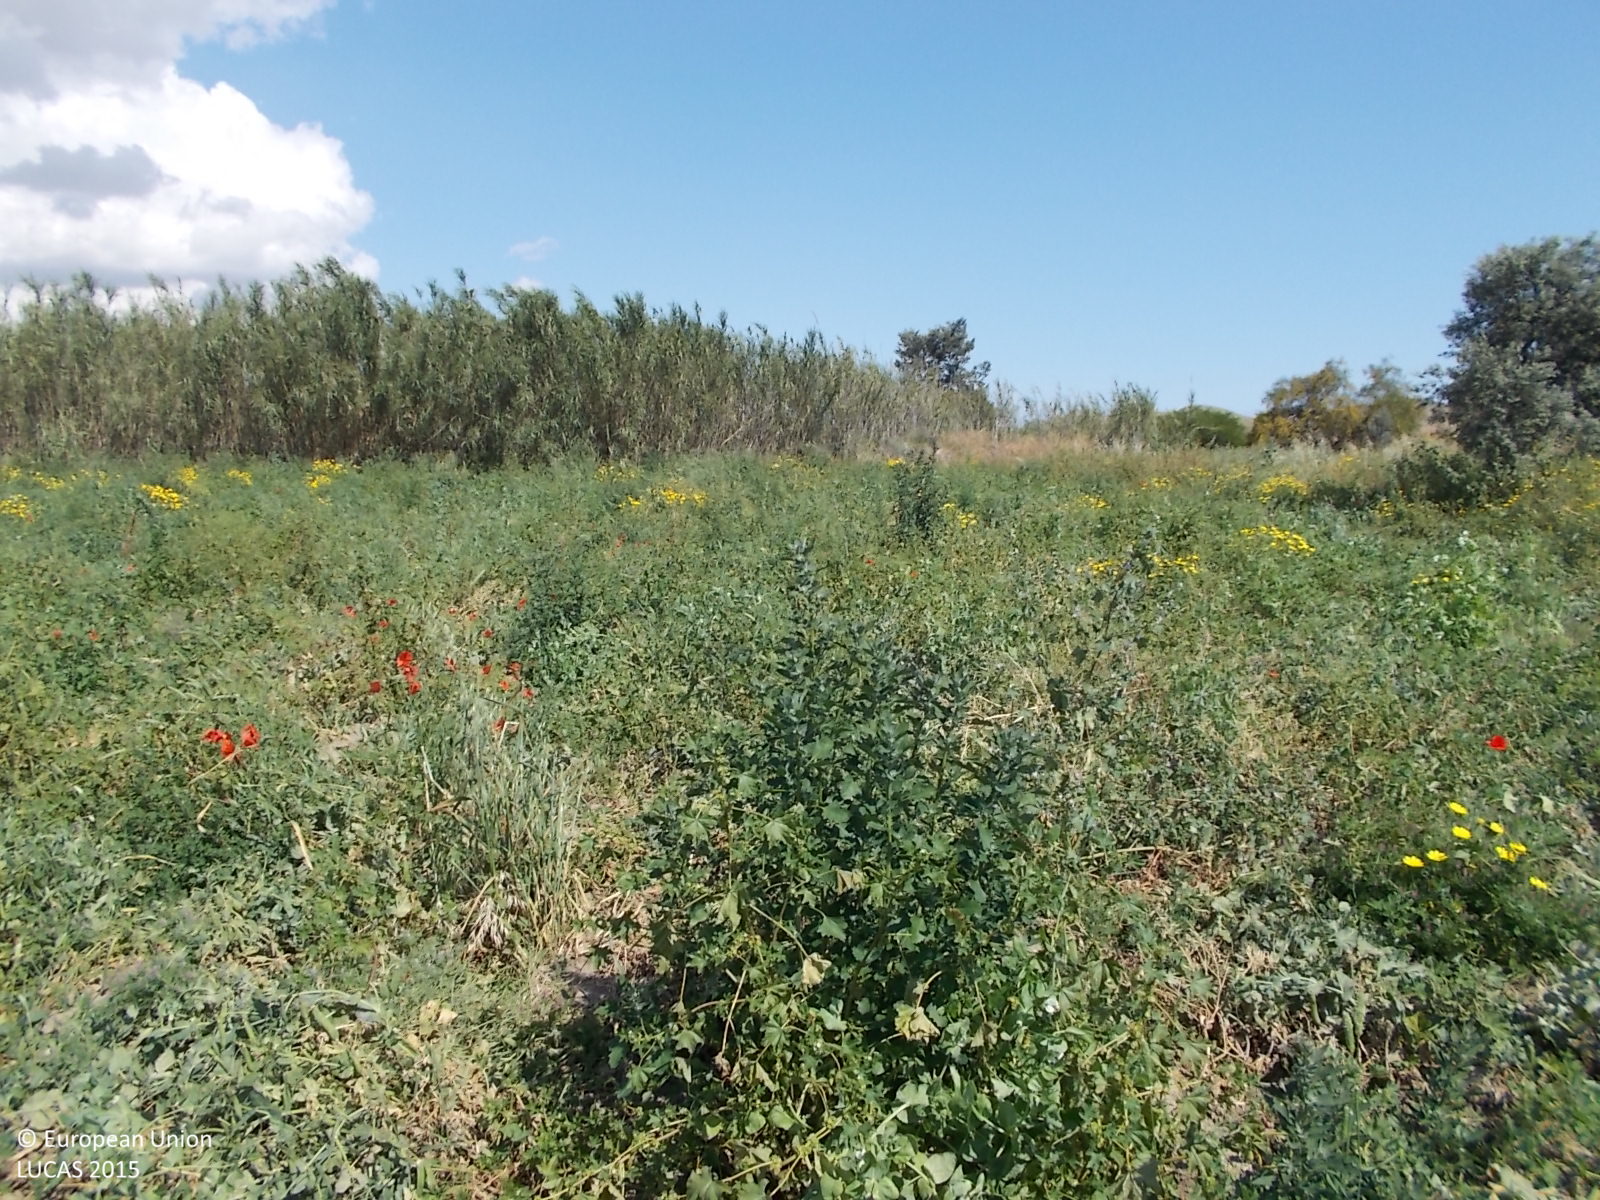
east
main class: Cropland
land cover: Dry pulses
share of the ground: > 75 %
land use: Agriculture (excluding fallow land and kitchen gardens)
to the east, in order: Dry pulses; Inland marshes; Olive groves; Permanent industrial crops; Other bare soil; Common wheat; Electric lines; Common wheat; Grass margins; Inland fresh running water; Grass margins; Other bare soil; Grass margins; Common wheat
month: April
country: CY
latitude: 35.0151
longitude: 33.5954
